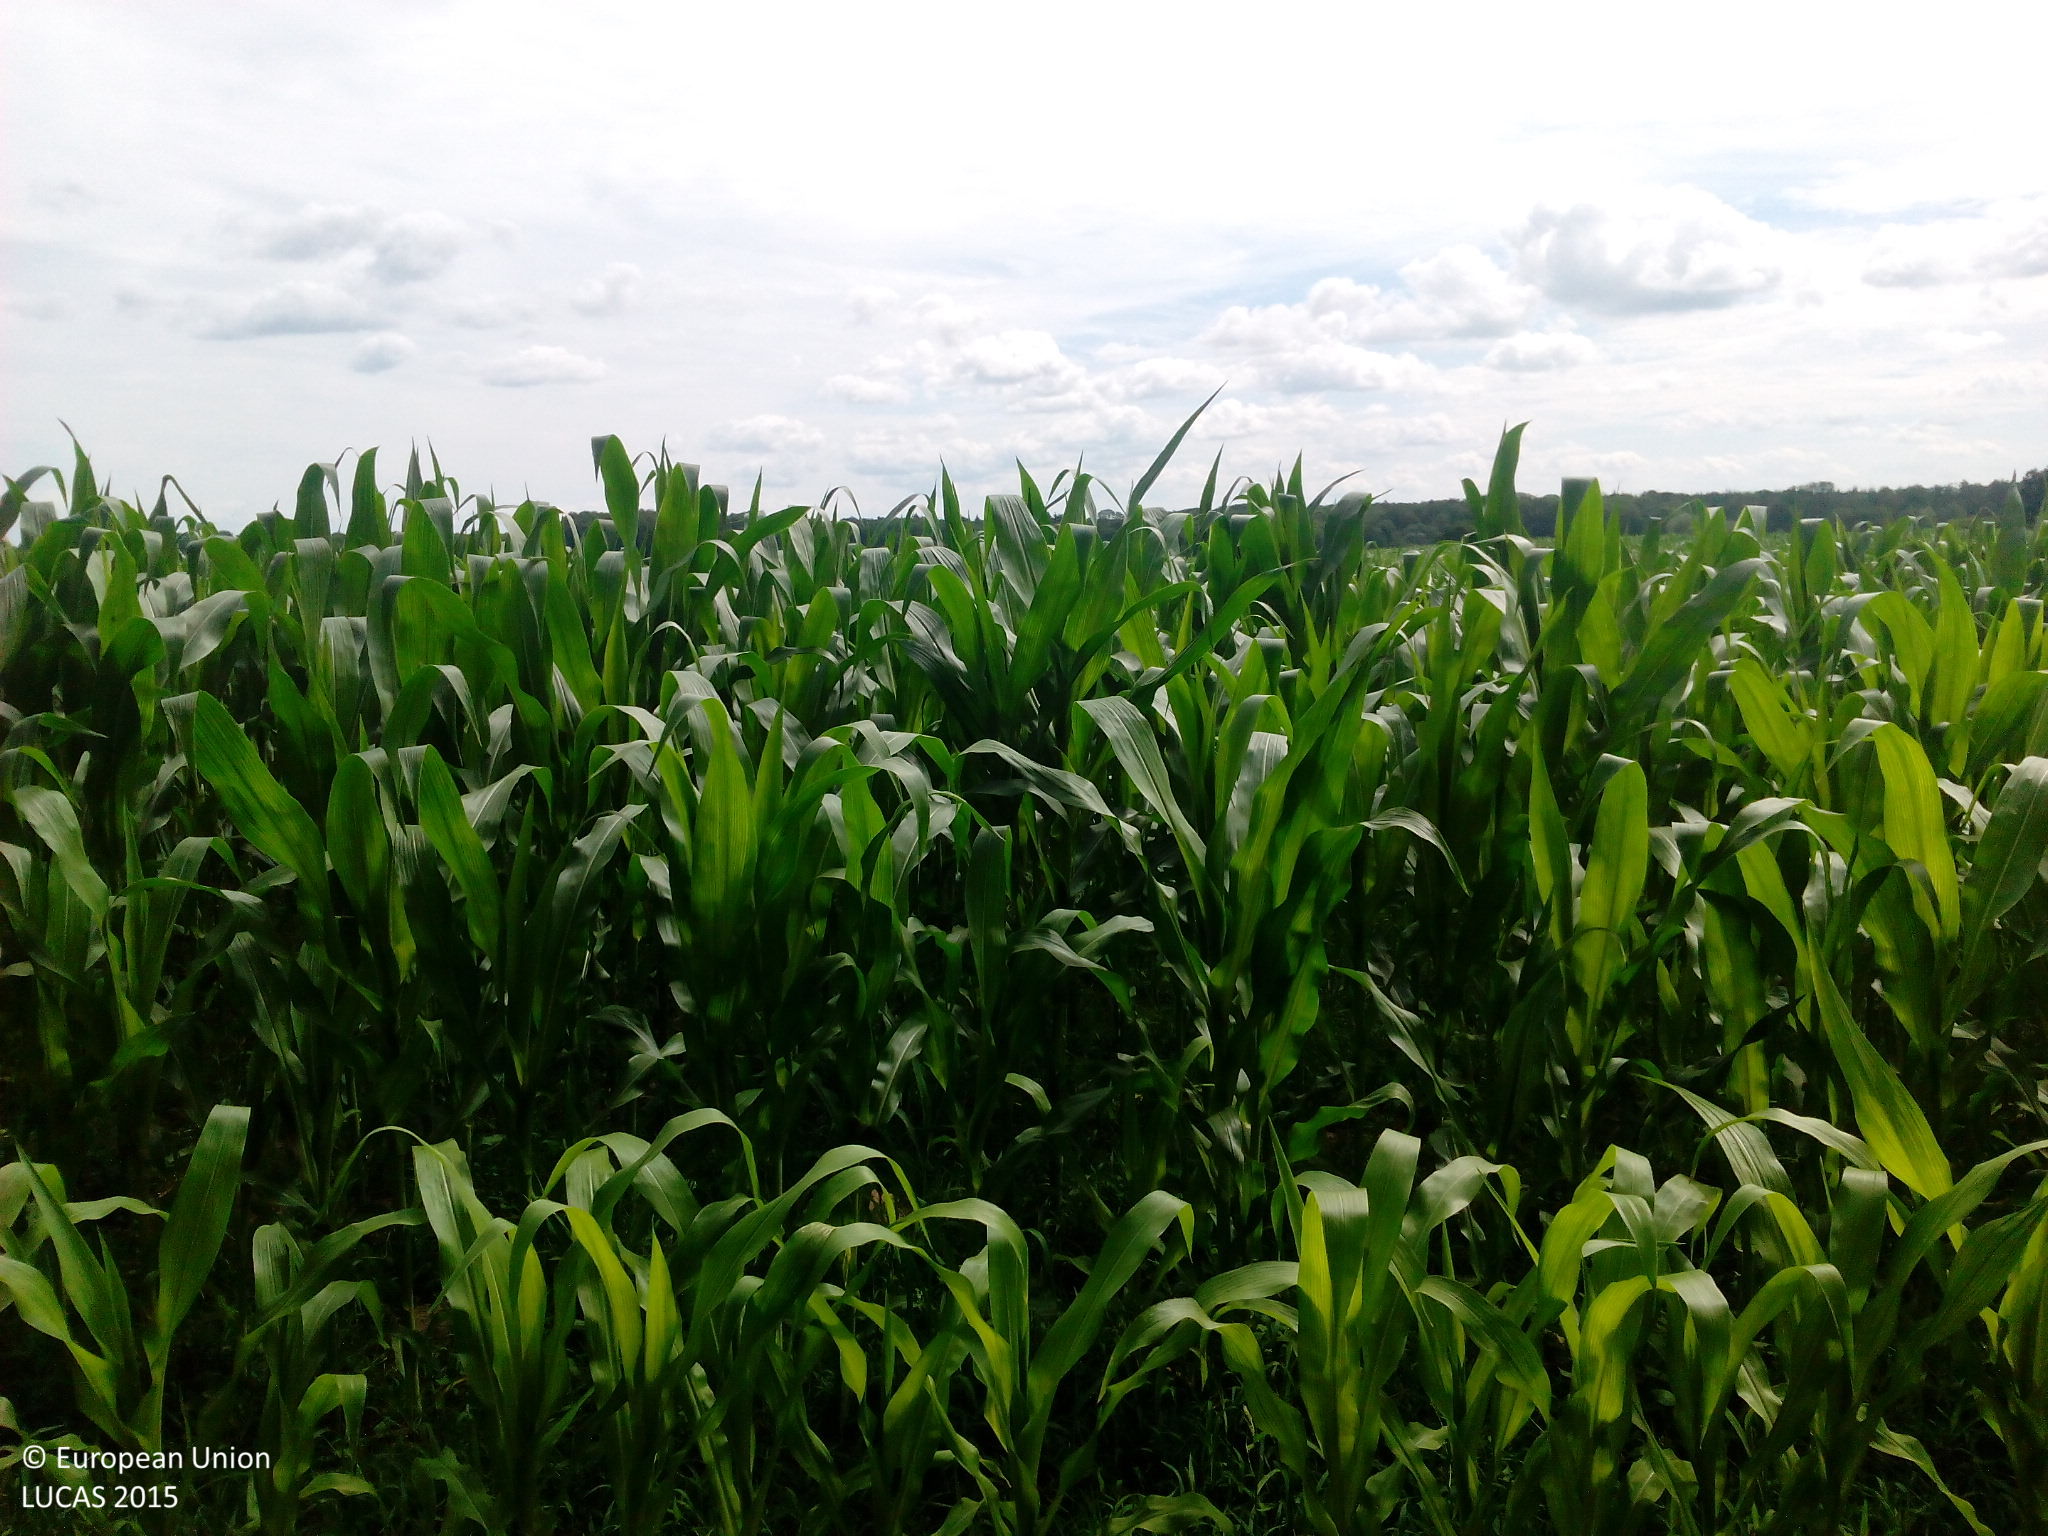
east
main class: Cropland
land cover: Maize
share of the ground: > 75 %
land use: Agriculture (excluding fallow land and kitchen gardens)
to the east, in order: Maize; Shrubland with sparse tree cover; Maize
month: July
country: DE
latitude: 53.7220
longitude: 13.7431
